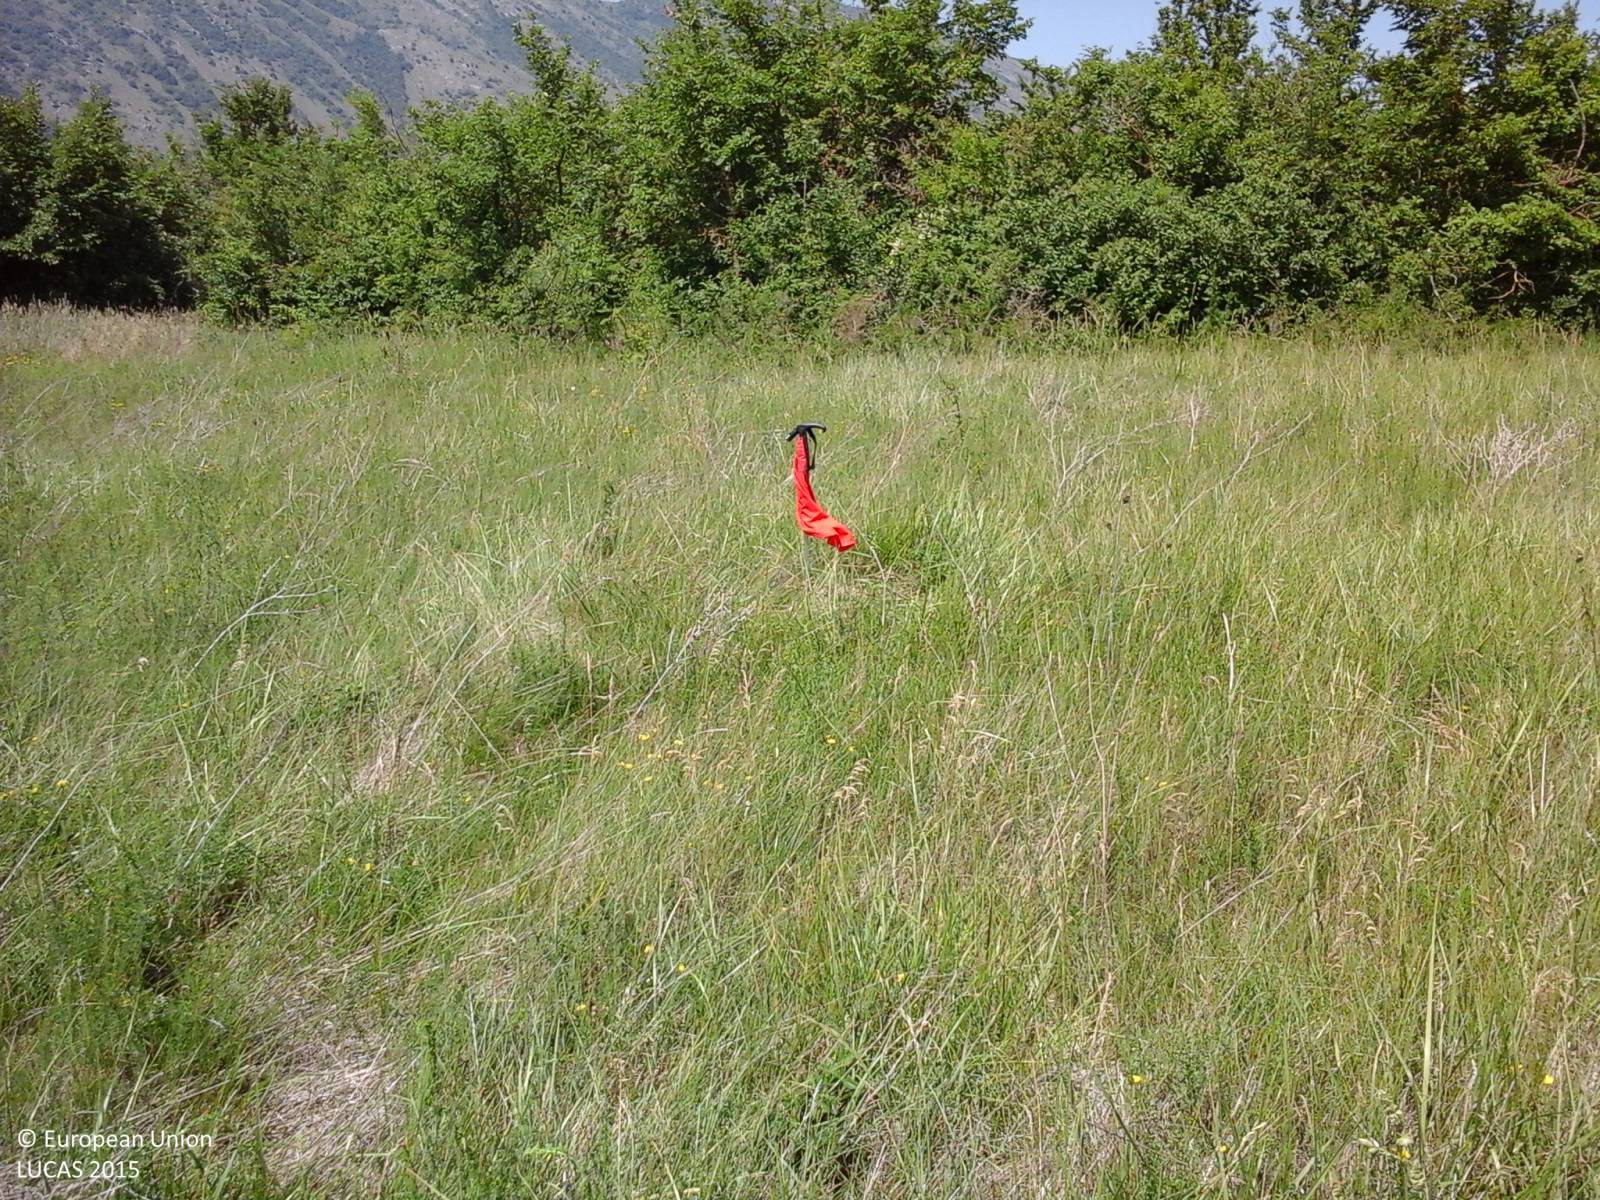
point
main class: Grassland
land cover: Grassland without tree/shrub cover
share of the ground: > 75 %
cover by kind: herbaceous plants 100 %
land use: Agriculture (excluding fallow land and kitchen gardens)
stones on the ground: < 10 %
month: June
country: IT
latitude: 42.0198
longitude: 13.3577
